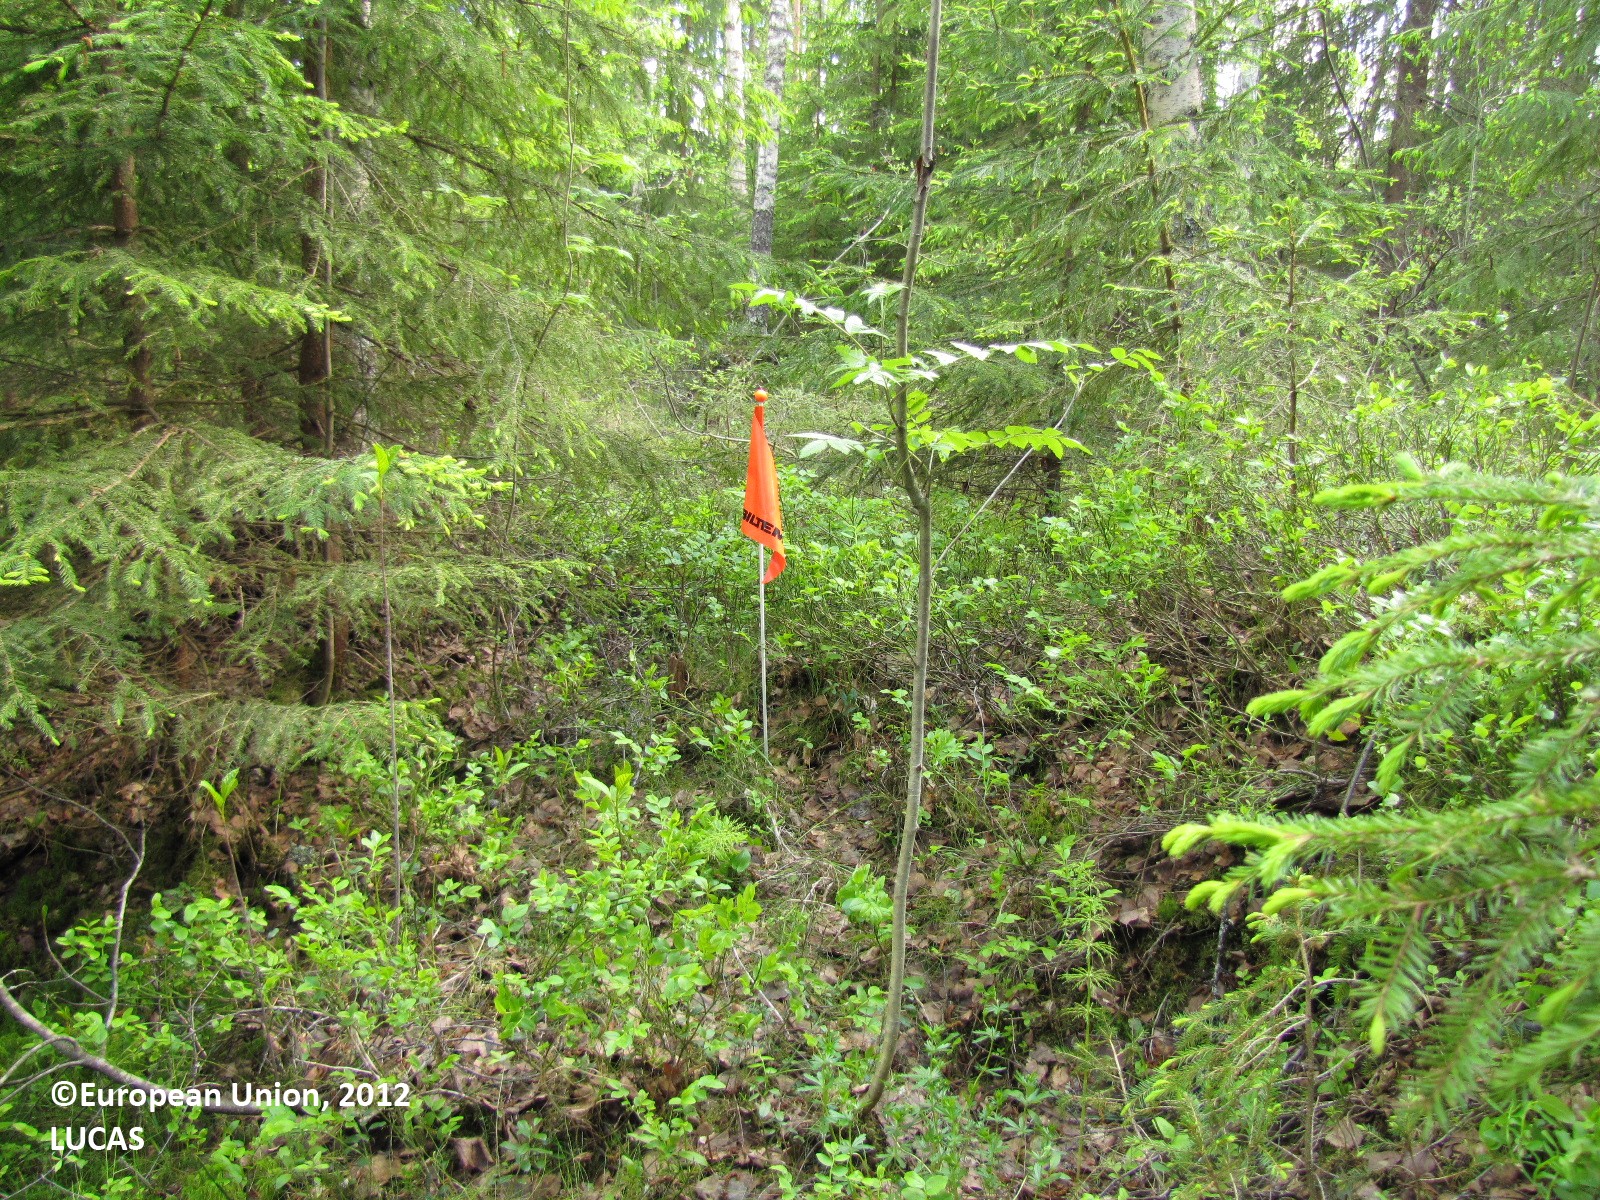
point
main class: Woodland
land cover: Other mixed woodland
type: boreal forest
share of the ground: > 75 %
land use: Forestry
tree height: > 5 m
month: June
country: FI
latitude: 61.4566
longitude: 23.0355
